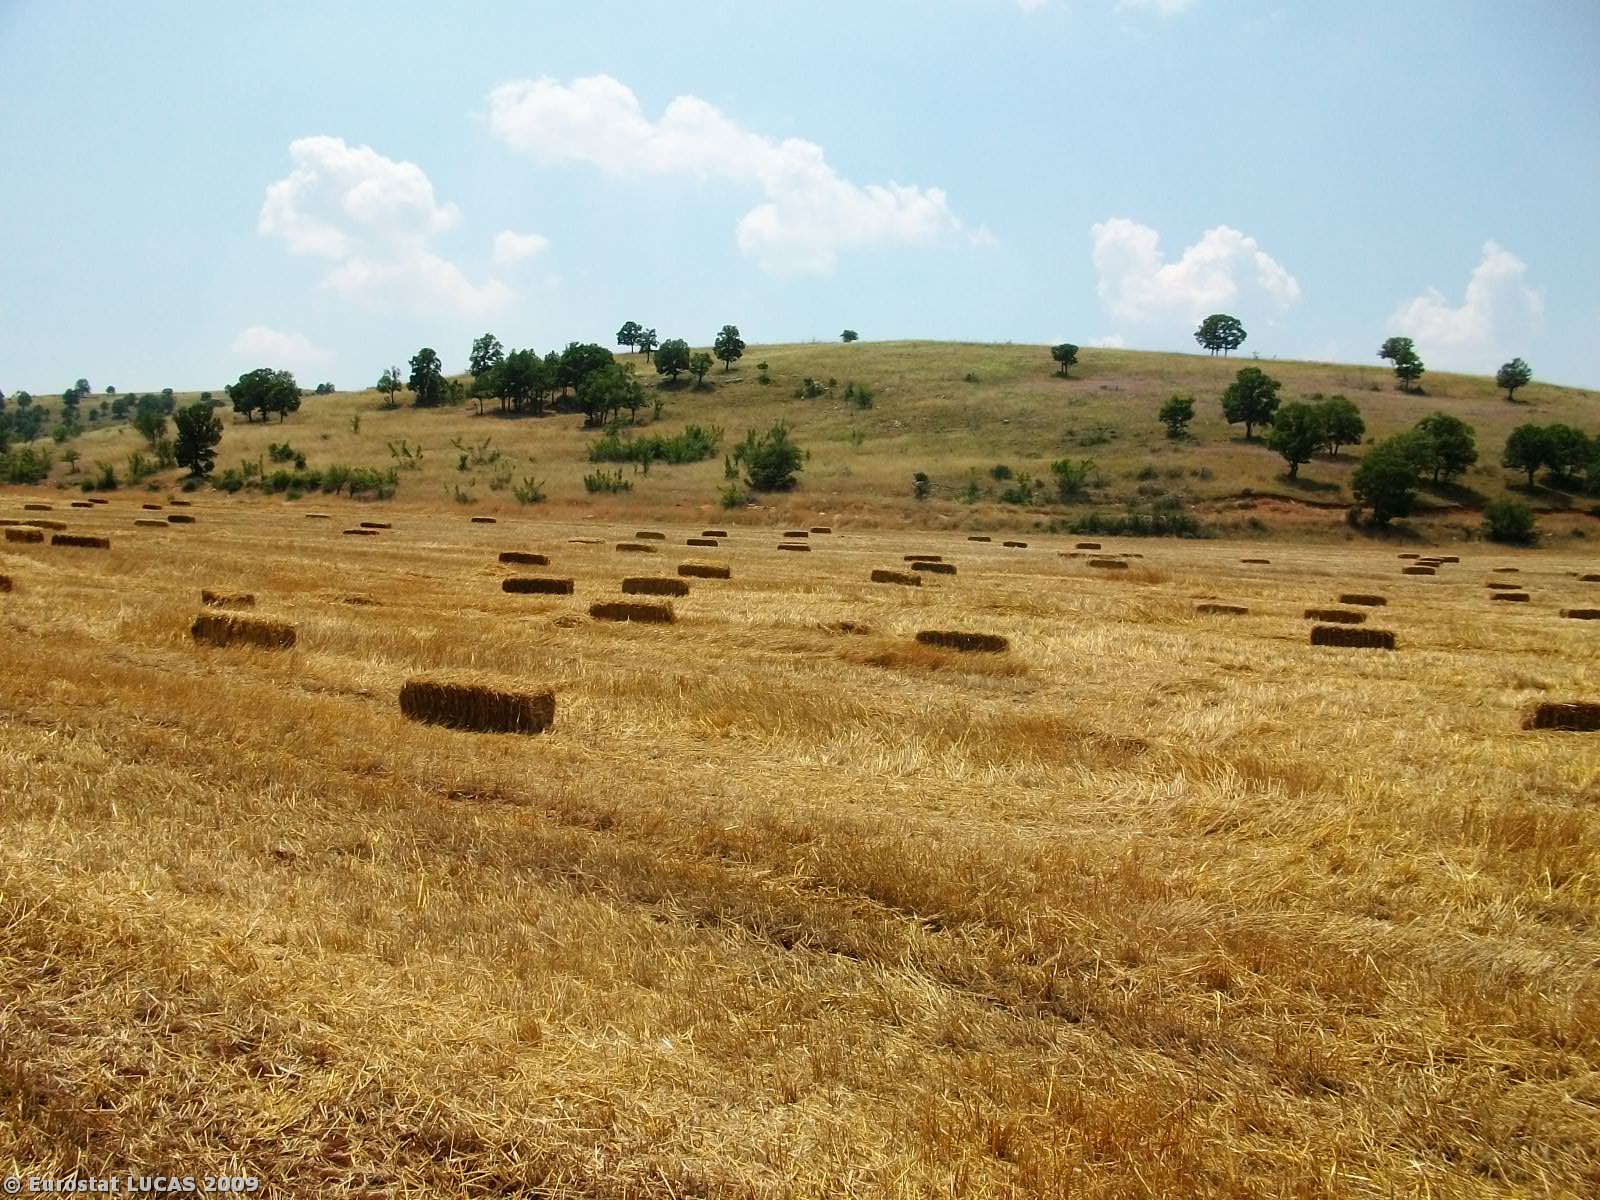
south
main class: Cropland
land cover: Durum wheat
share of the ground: < 10 %
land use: Agriculture (excluding fallow land and kitchen gardens)
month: July
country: GR
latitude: 40.6978
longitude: 21.8430
